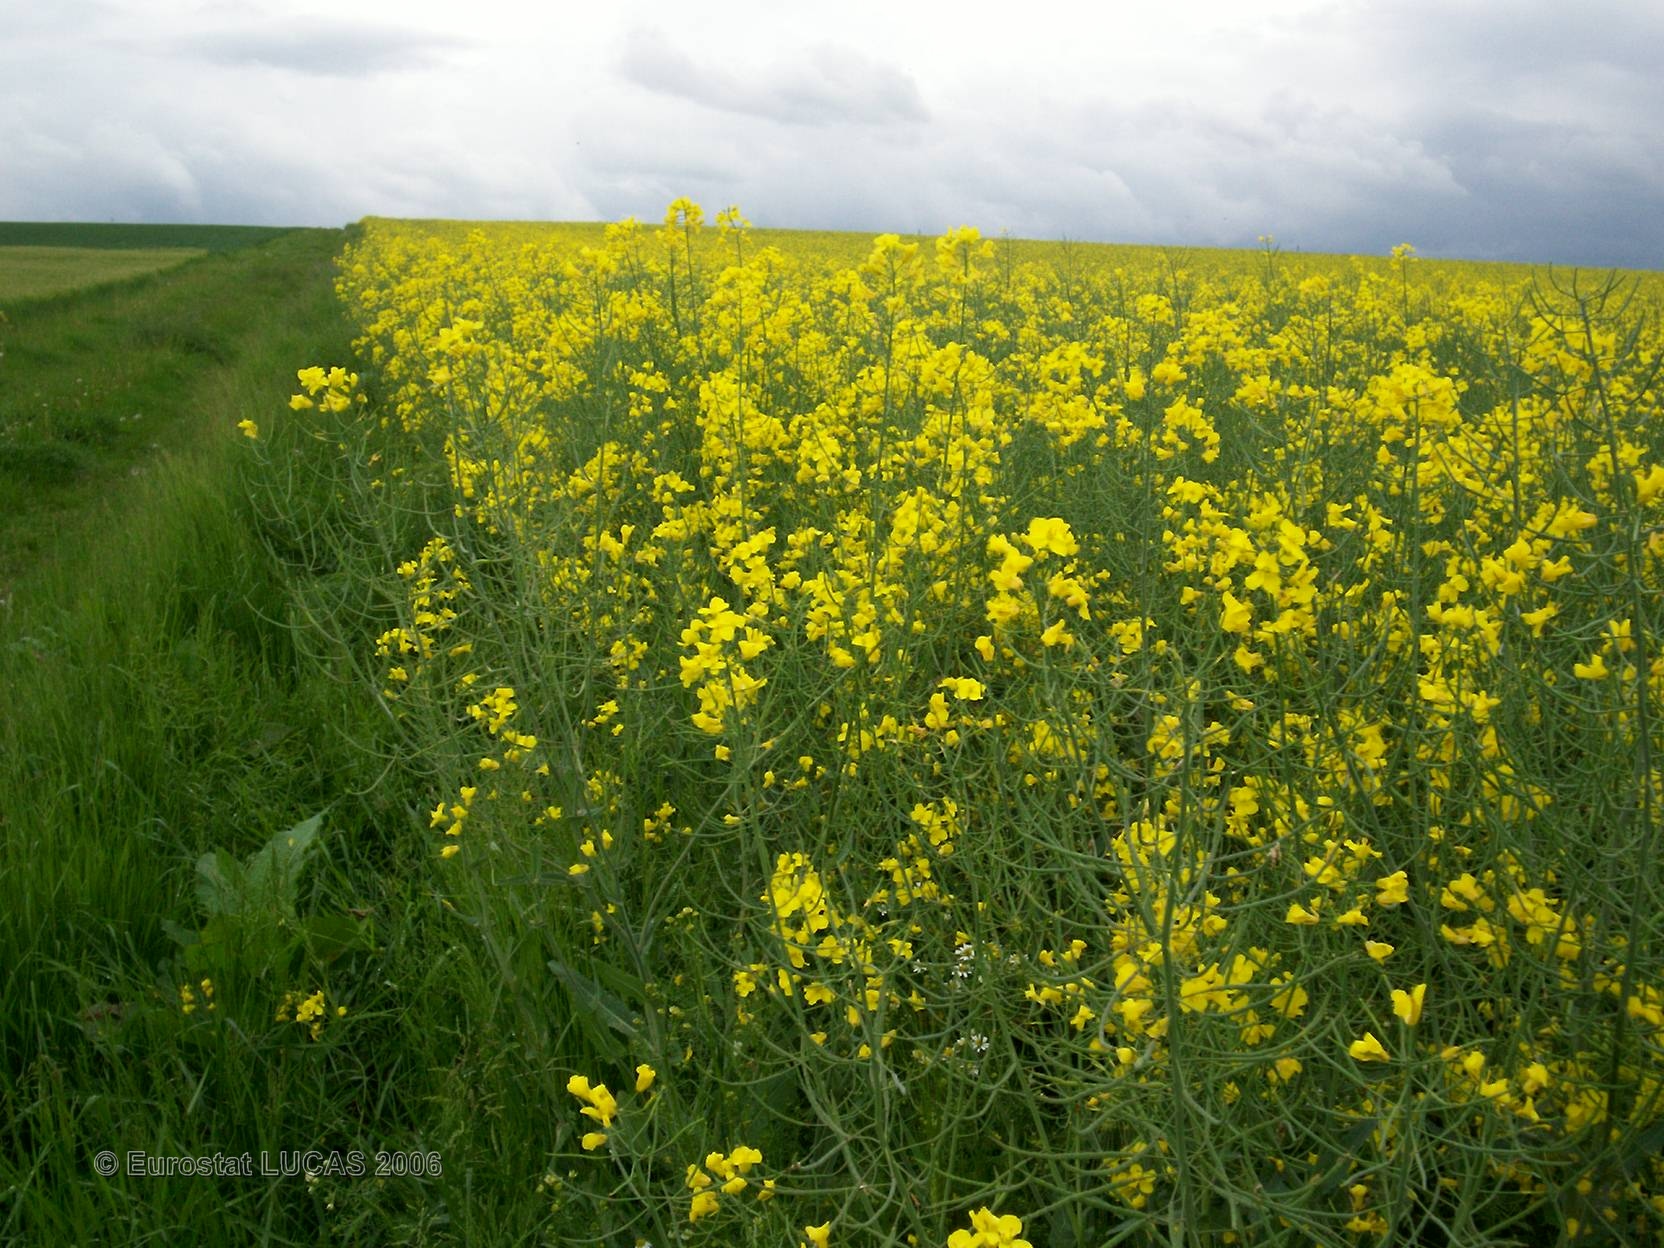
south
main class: Cropland
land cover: Rape and turnip rape
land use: Agriculture (excluding fallow land and kitchen gardens)
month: May
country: FR
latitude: 48.1943
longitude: 4.4954
